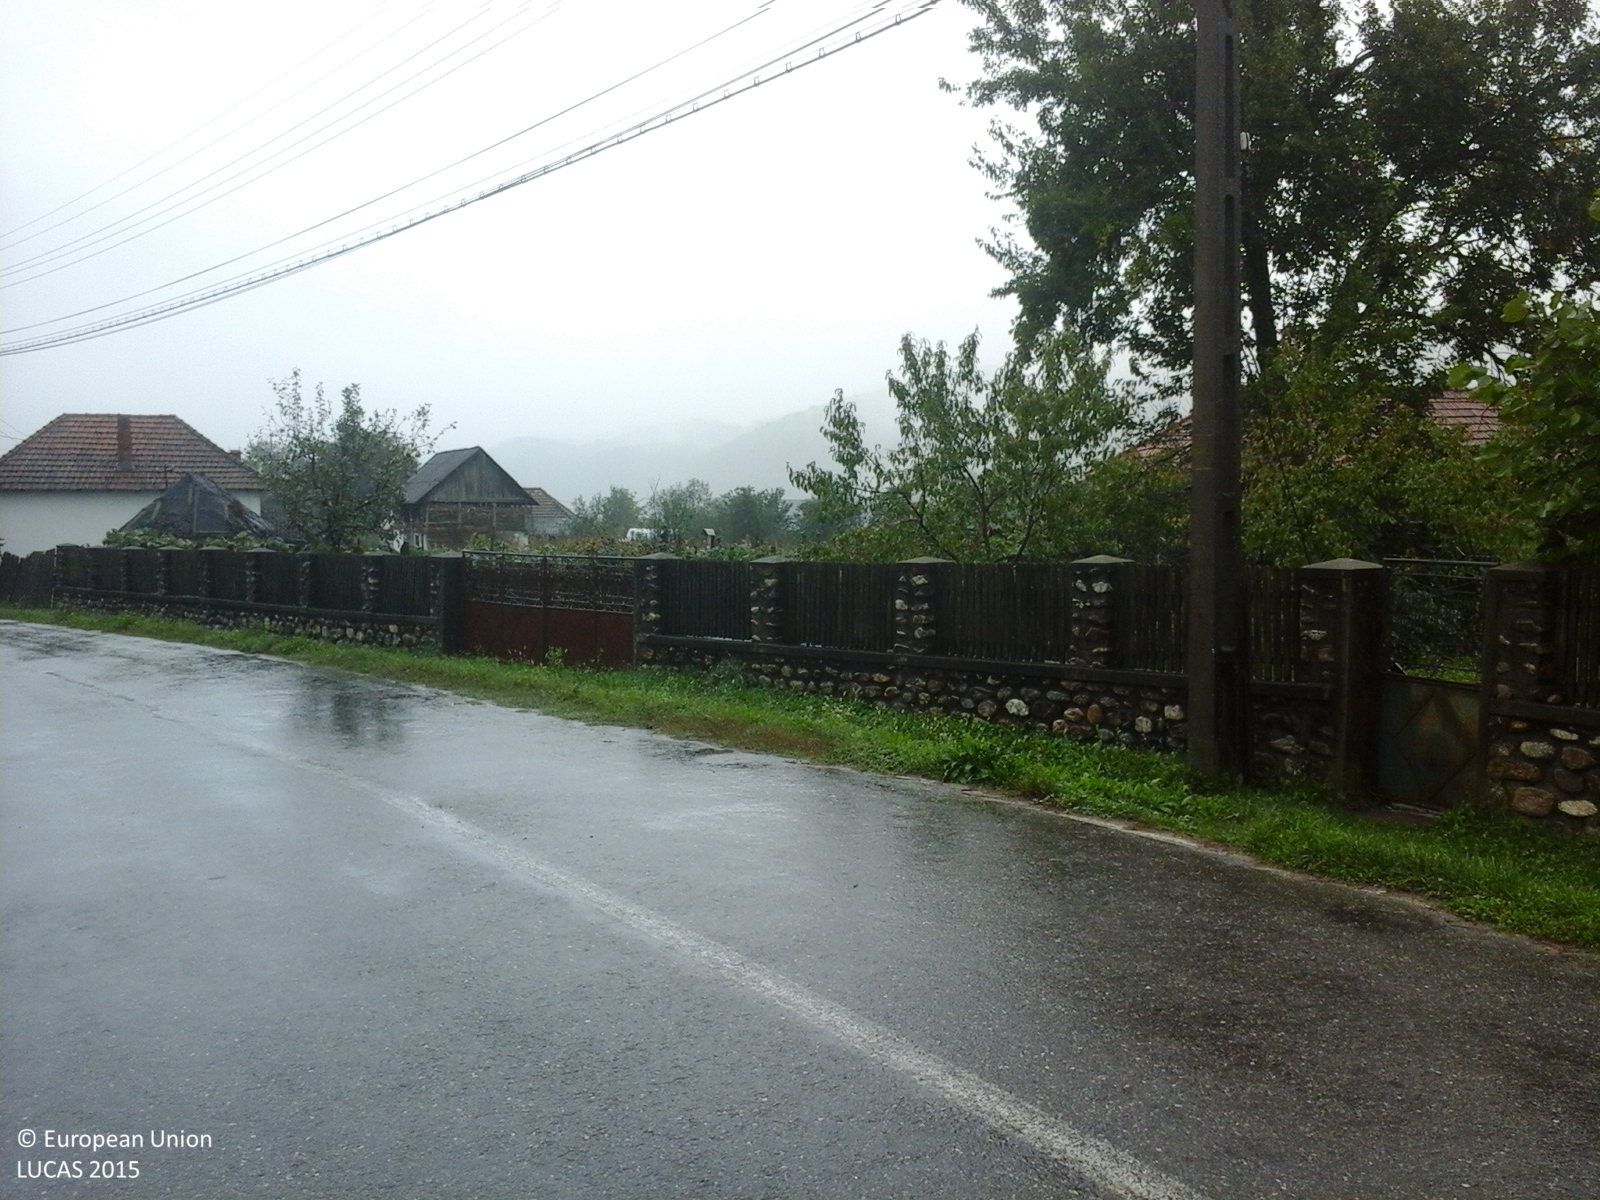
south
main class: Cropland
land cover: Apple fruit
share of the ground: 50 - 75 %
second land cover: Grassland without tree/shrub cover
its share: > 75 %
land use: Agriculture (excluding fallow land and kitchen gardens)
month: September
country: RO
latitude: 45.1129
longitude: 24.0109
